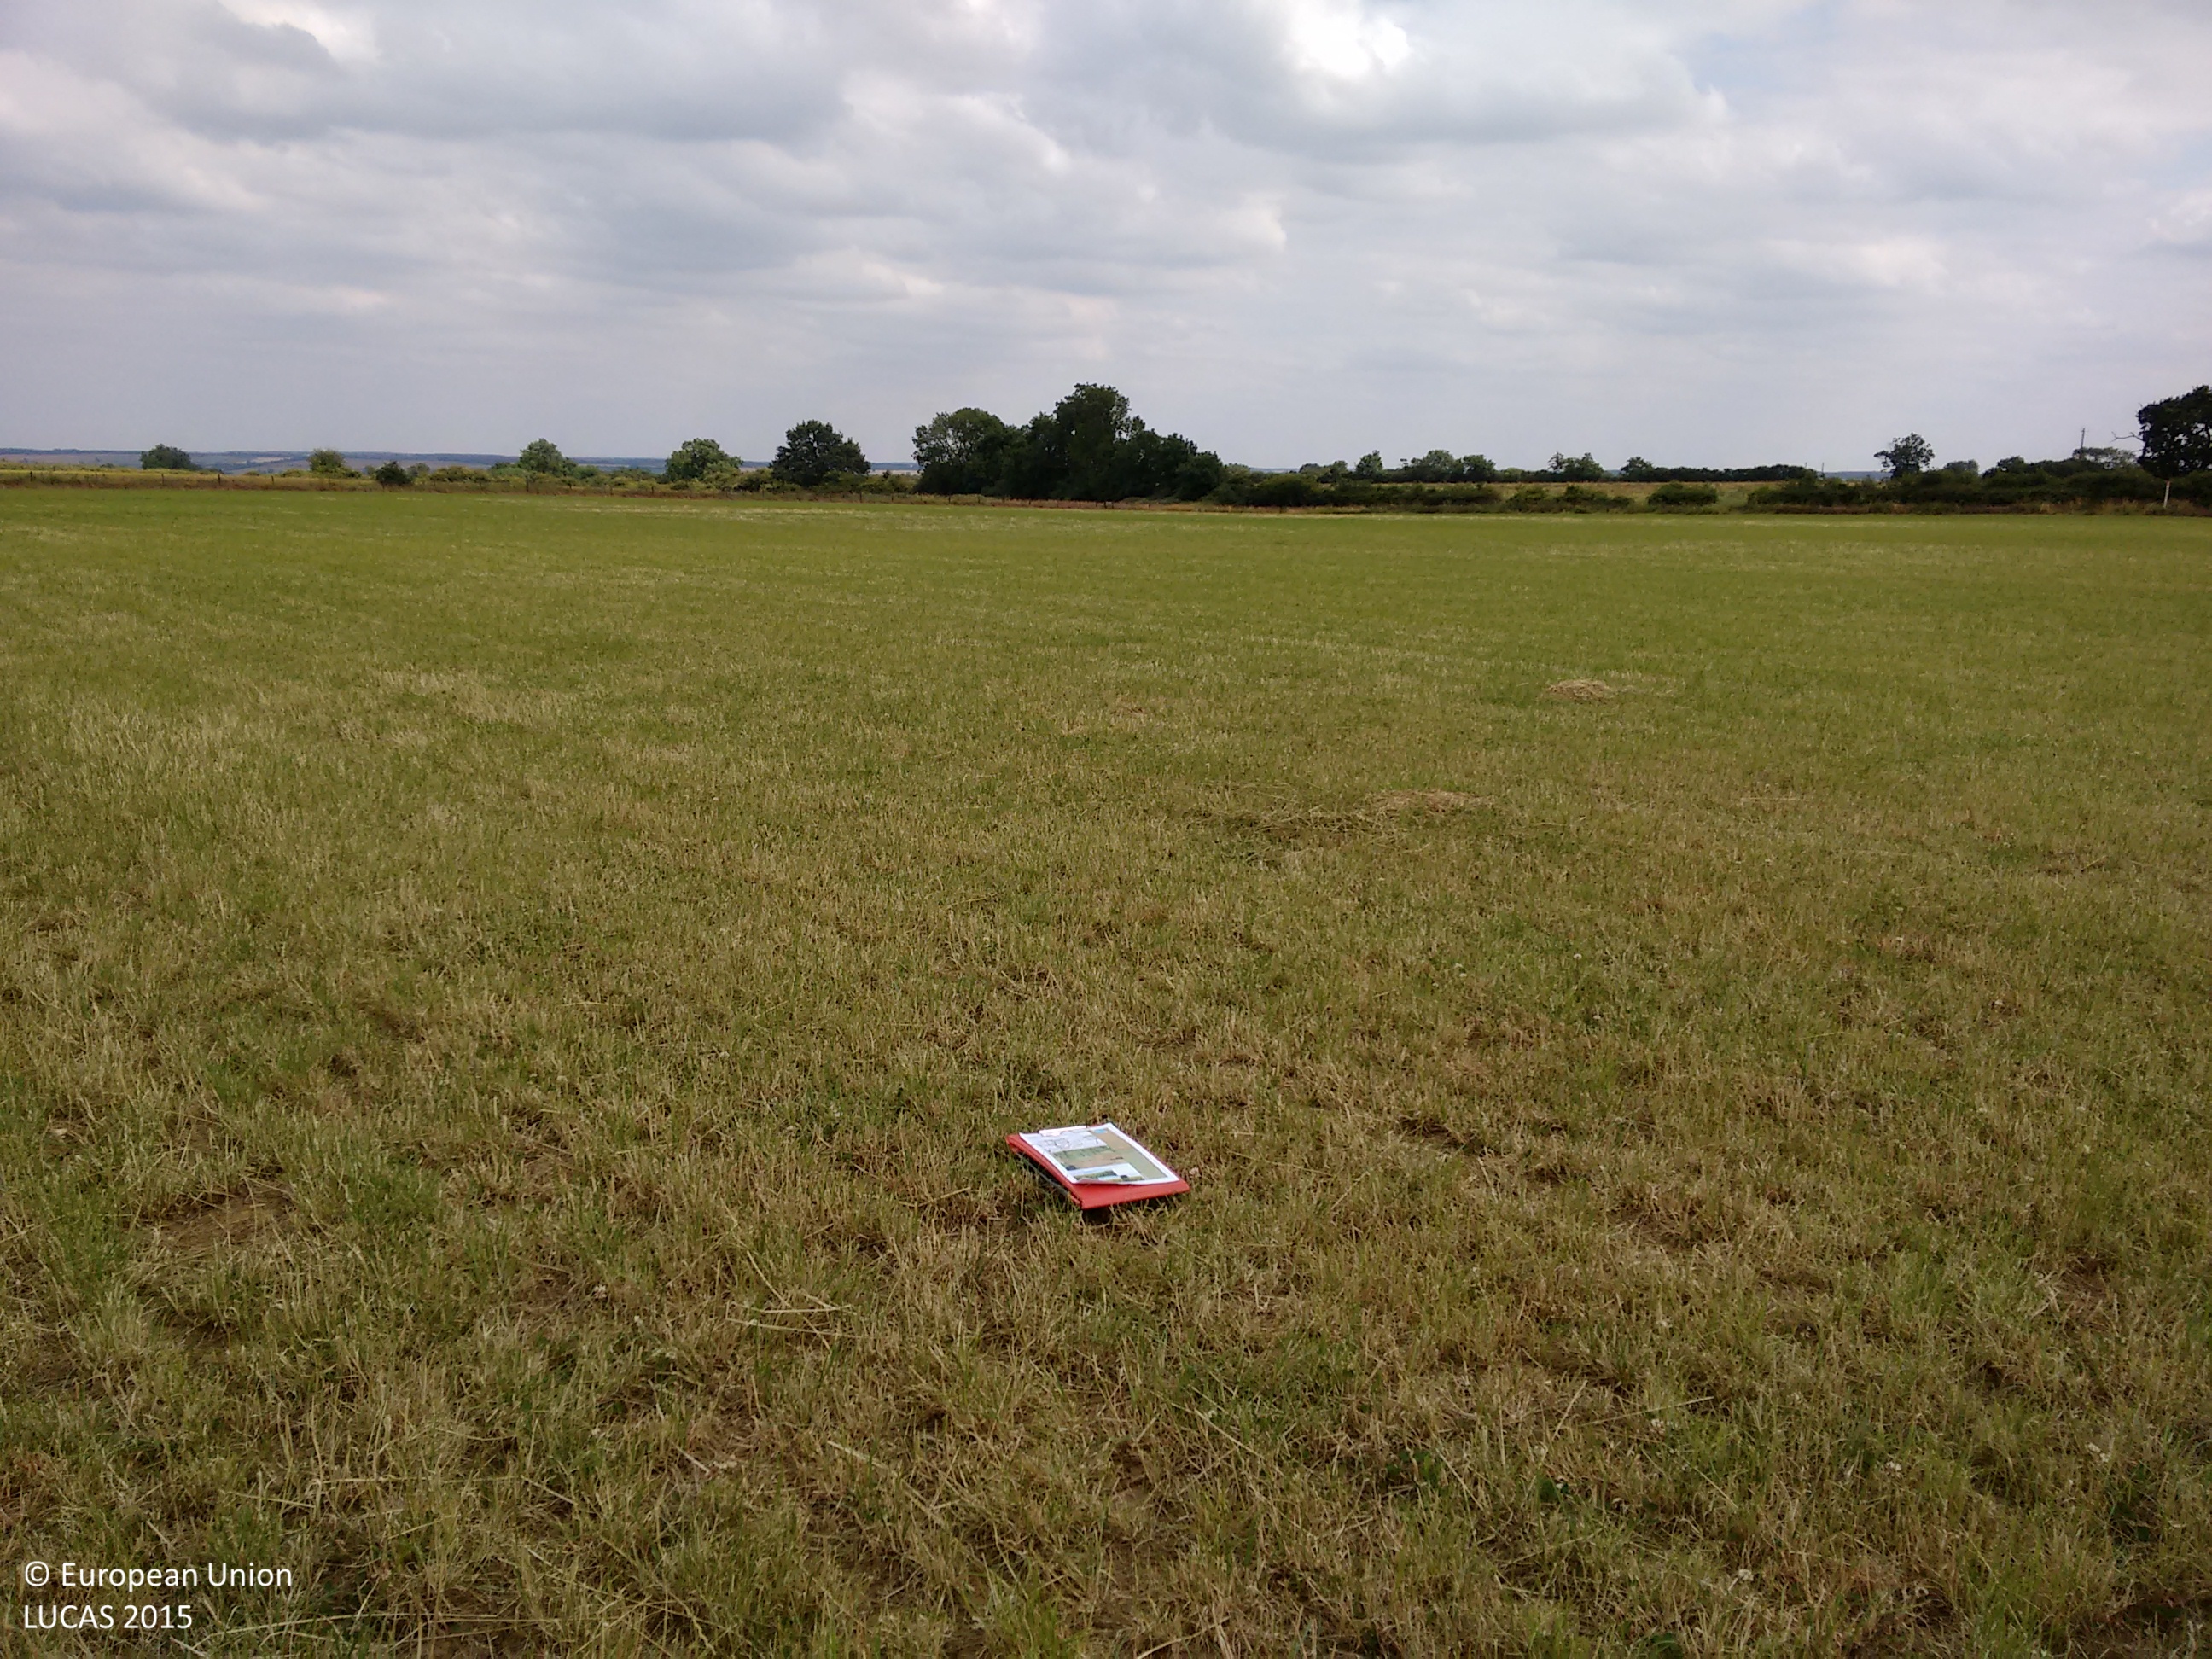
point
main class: Grassland
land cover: Grassland without tree/shrub cover
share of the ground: > 75 %
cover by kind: herbaceous plants 100 %
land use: Agriculture (excluding fallow land and kitchen gardens)
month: July
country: GB
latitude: 52.5781
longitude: -0.7397
